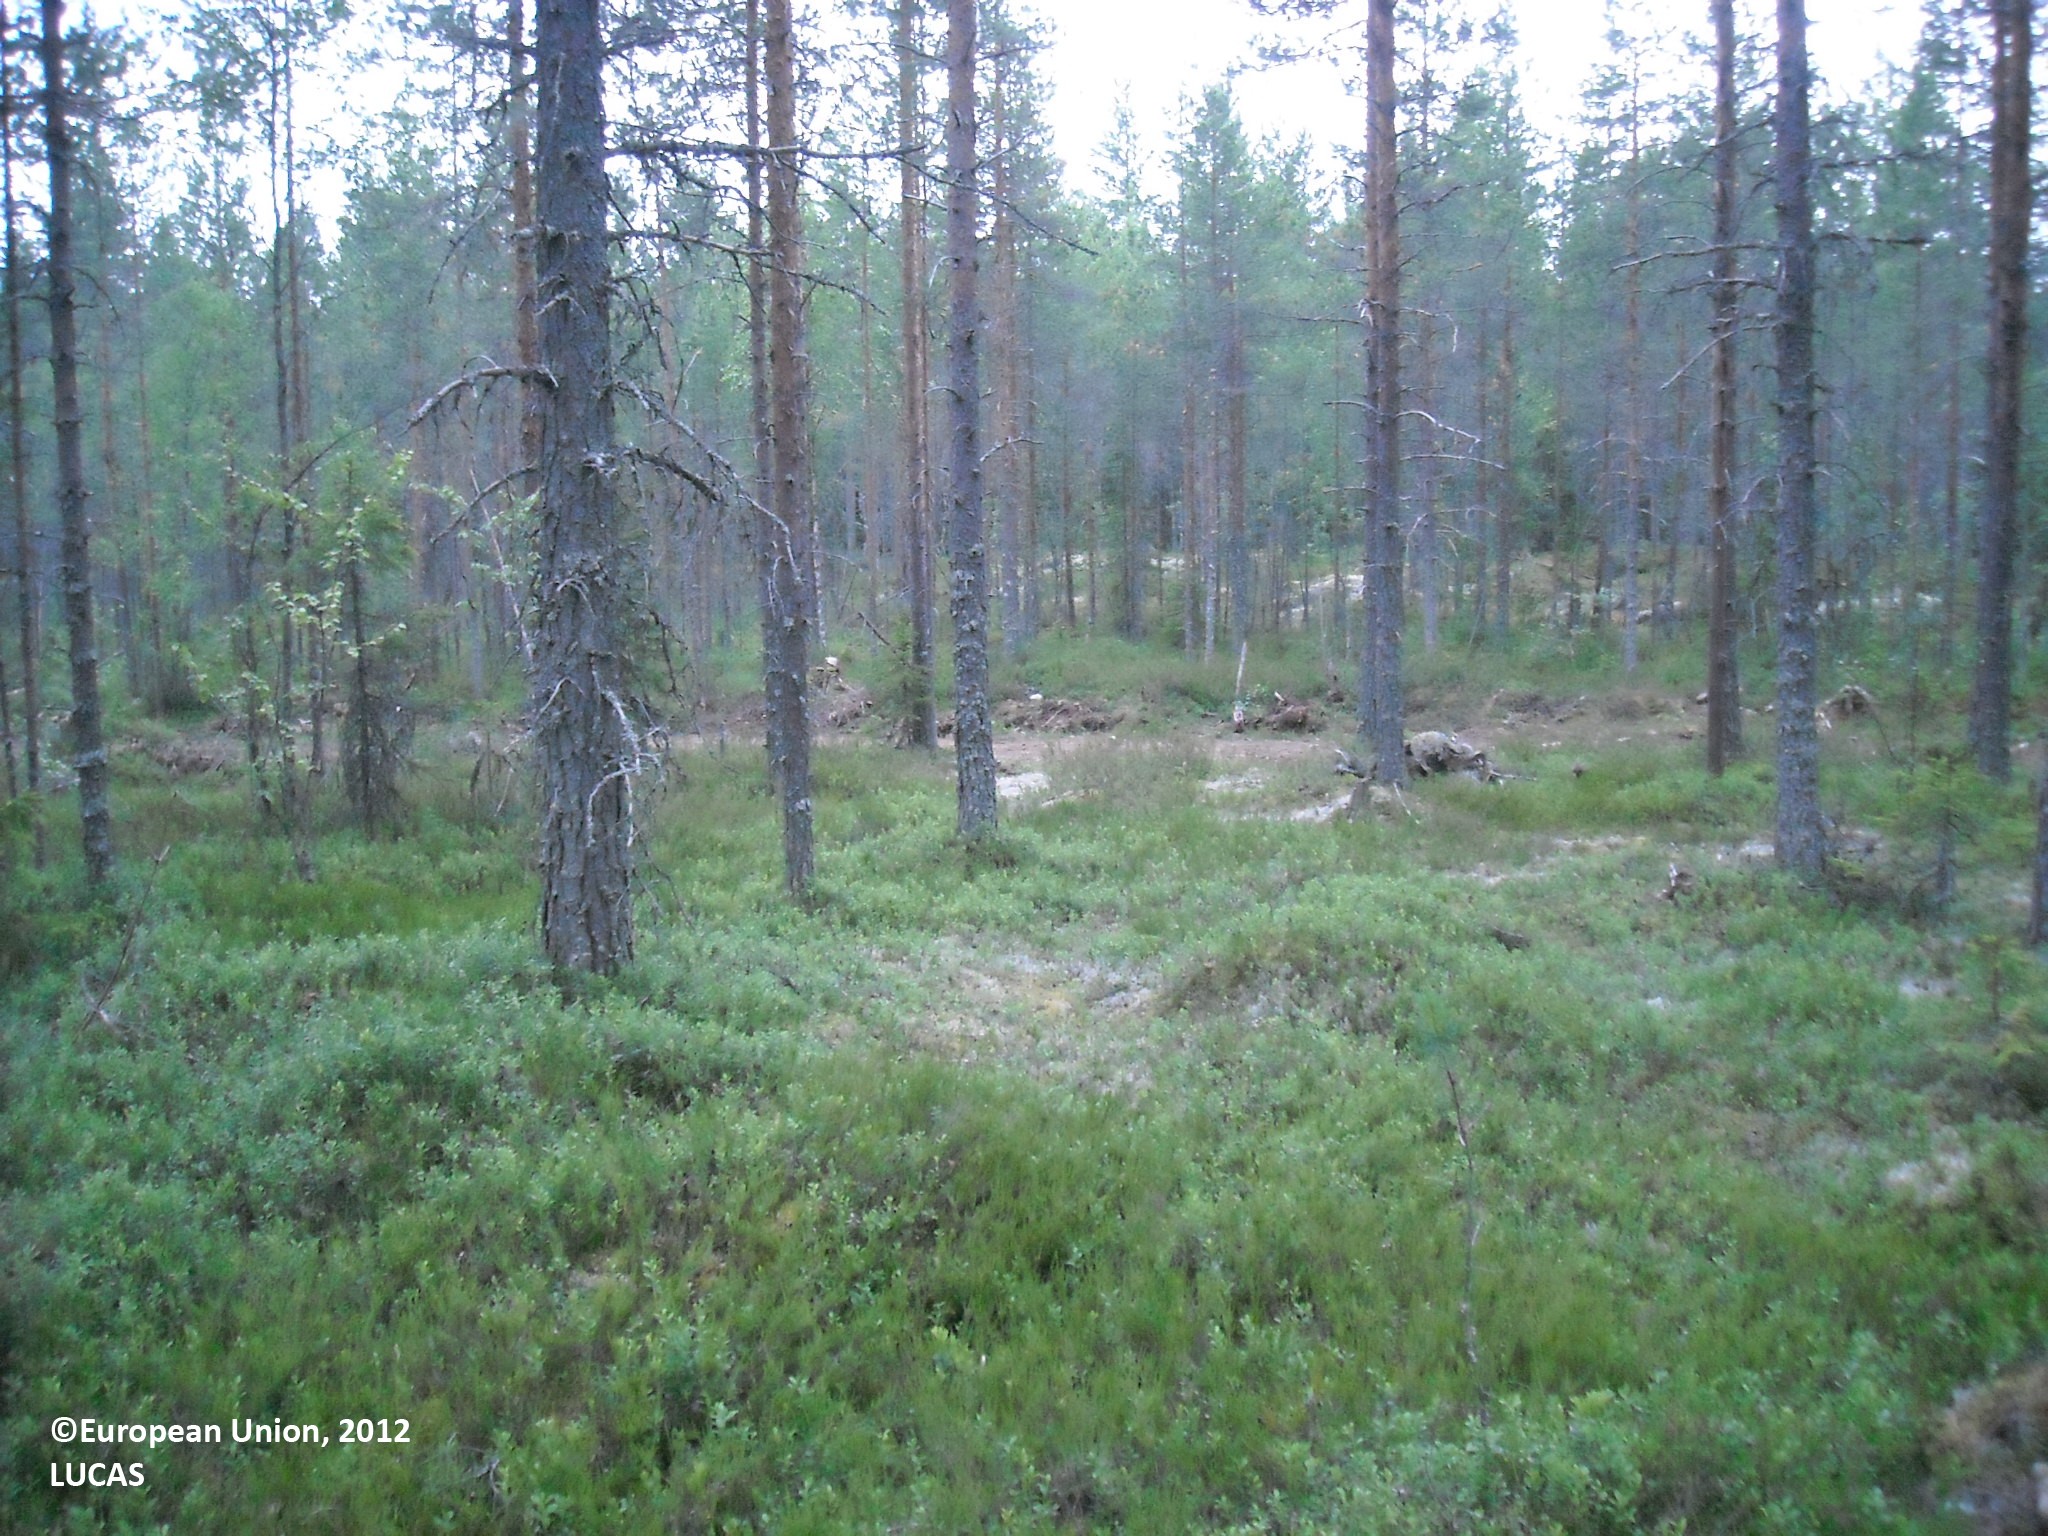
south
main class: Woodland
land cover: Pine dominated coniferous woodland
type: boreal forest
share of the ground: 50 - 75 %
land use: Forestry
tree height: > 5 m
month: July
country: FI
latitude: 64.8221
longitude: 26.8684
